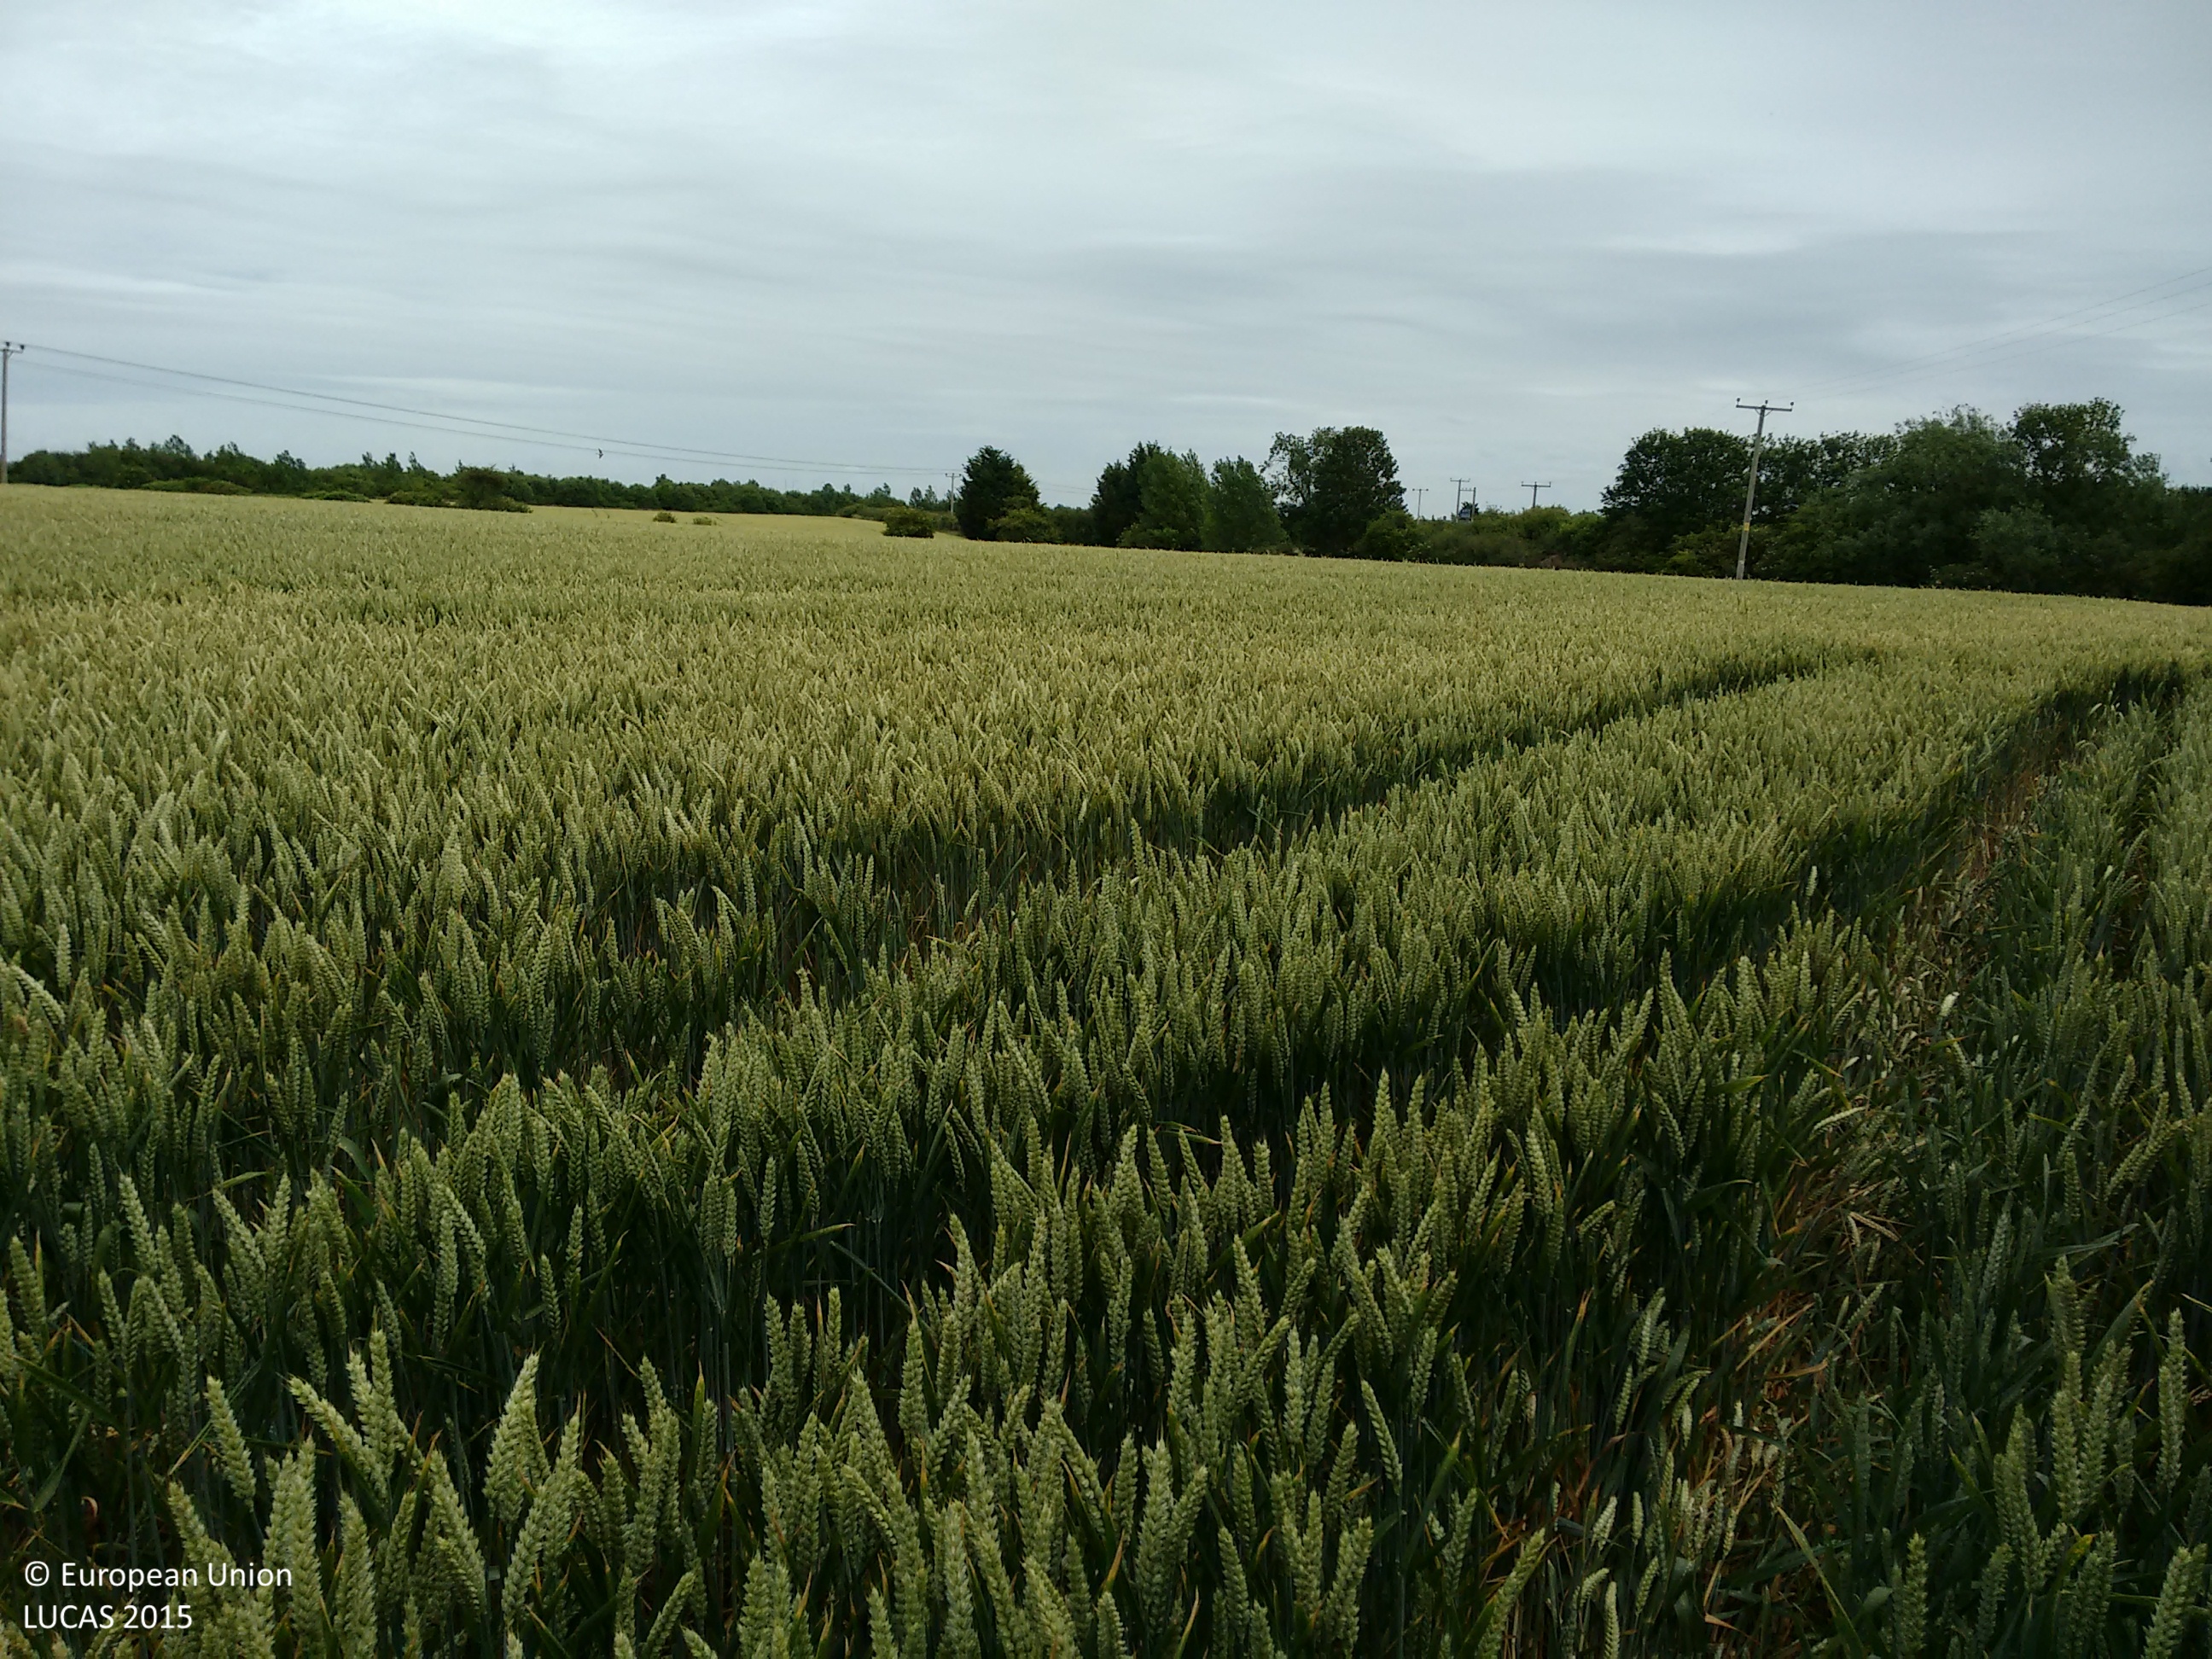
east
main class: Woodland
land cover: Broadleaved woodland
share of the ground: > 75 %
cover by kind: broadleaved forest trees 75 %, shrubs 15 %, herbaceous plants 10 %
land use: Agriculture (excluding fallow land and kitchen gardens)
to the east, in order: Broadleaved woodland; Grass margins; Common wheat; Grass margins; Managed hedges; Grass margins; Tracks; Grass margins; Managed hedges; Grass margins; Common wheat
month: July
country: GB
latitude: 51.7728
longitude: -1.5737
